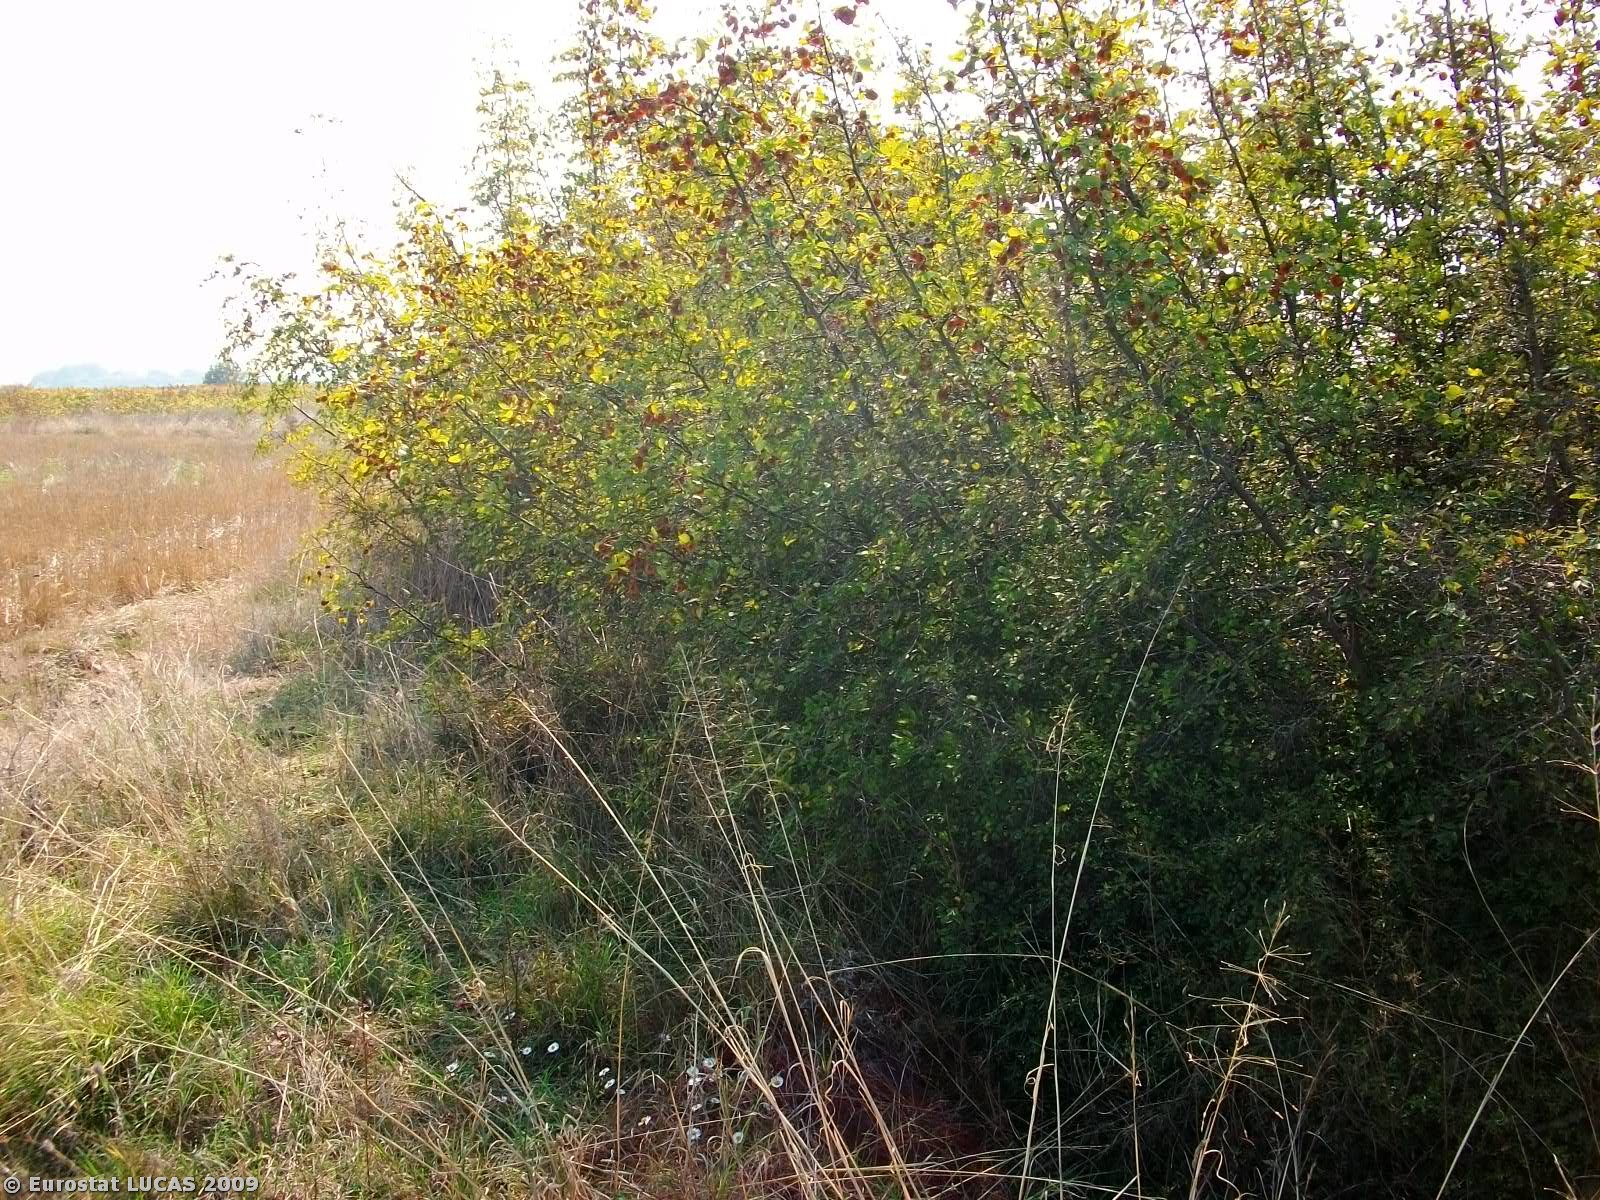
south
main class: Shrubland
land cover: Shrubland with sparse tree cover
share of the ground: 25 - 50 %
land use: Unused
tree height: > 5 m
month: October
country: GR
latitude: 41.0676
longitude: 26.2884
